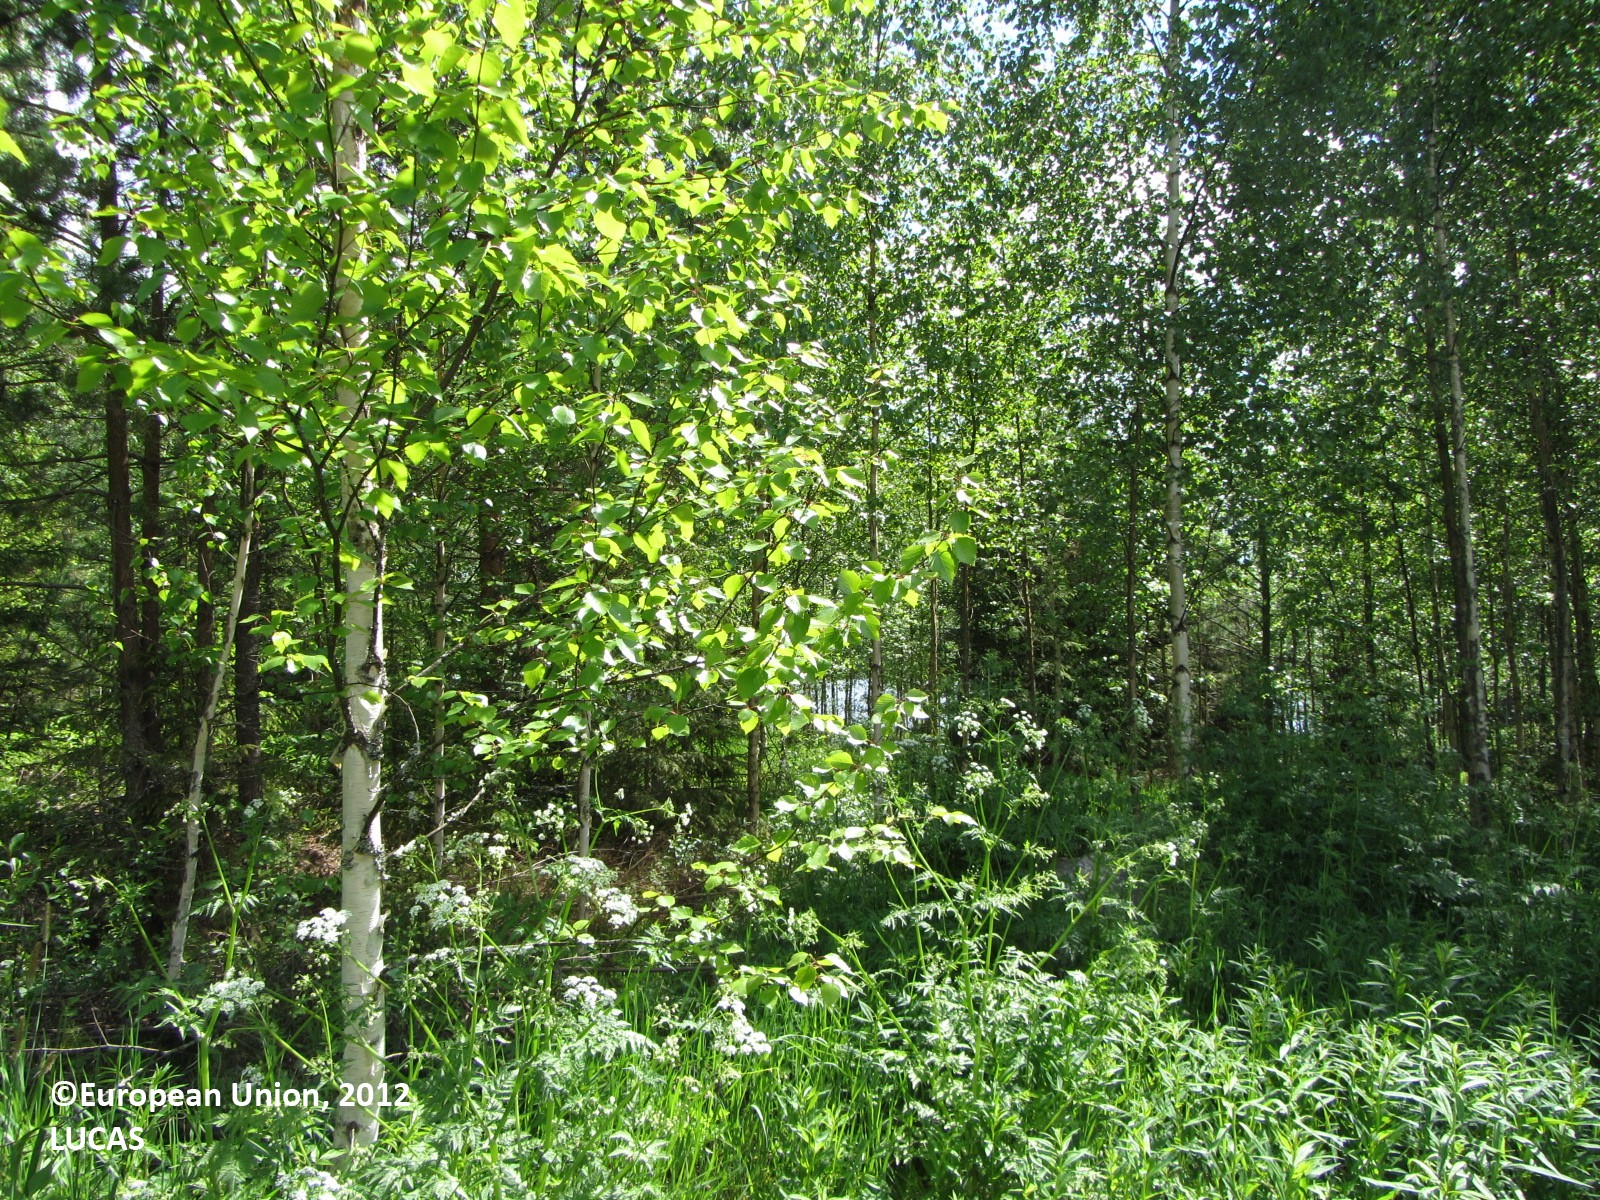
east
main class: Grassland
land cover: Spontaneously vegetated surfaces
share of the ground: 50 - 75 %
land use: Semi-natural and natural areas not in use
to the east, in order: Spontaneously vegetated surfaces; Other mixed woodland; Broadleaved woodland; Spontaneously vegetated surfaces; Artificial constructions in urban areas; Broadleaved woodland; Spontaneously vegetated surfaces; Broadleaved woodland; Spruce dominated coniferous woodland; Rock outcrops; Spruce dominated mixed woodland
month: June
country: FI
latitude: 61.9953
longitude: 24.7030
